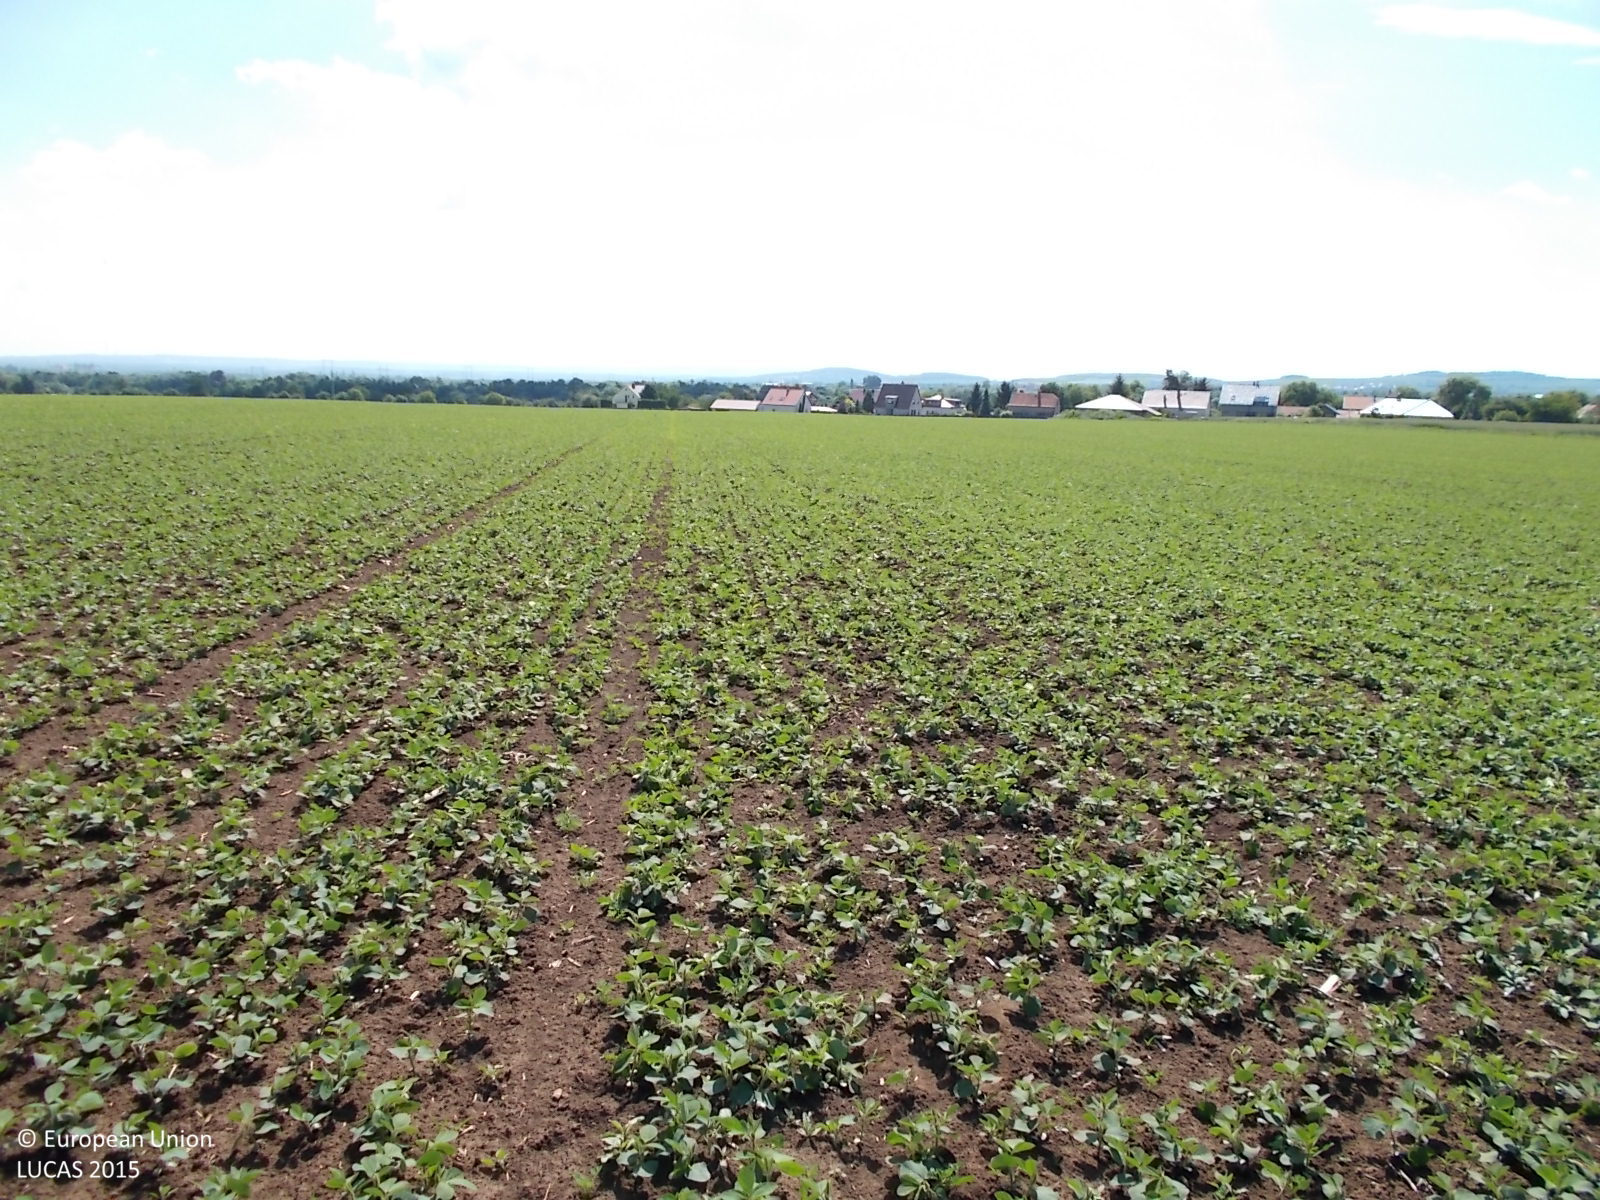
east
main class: Cropland
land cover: Soya
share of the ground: 25 - 50 %
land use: Agriculture (excluding fallow land and kitchen gardens)
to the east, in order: Soya
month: June
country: CZ
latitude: 50.0137
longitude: 15.1525
